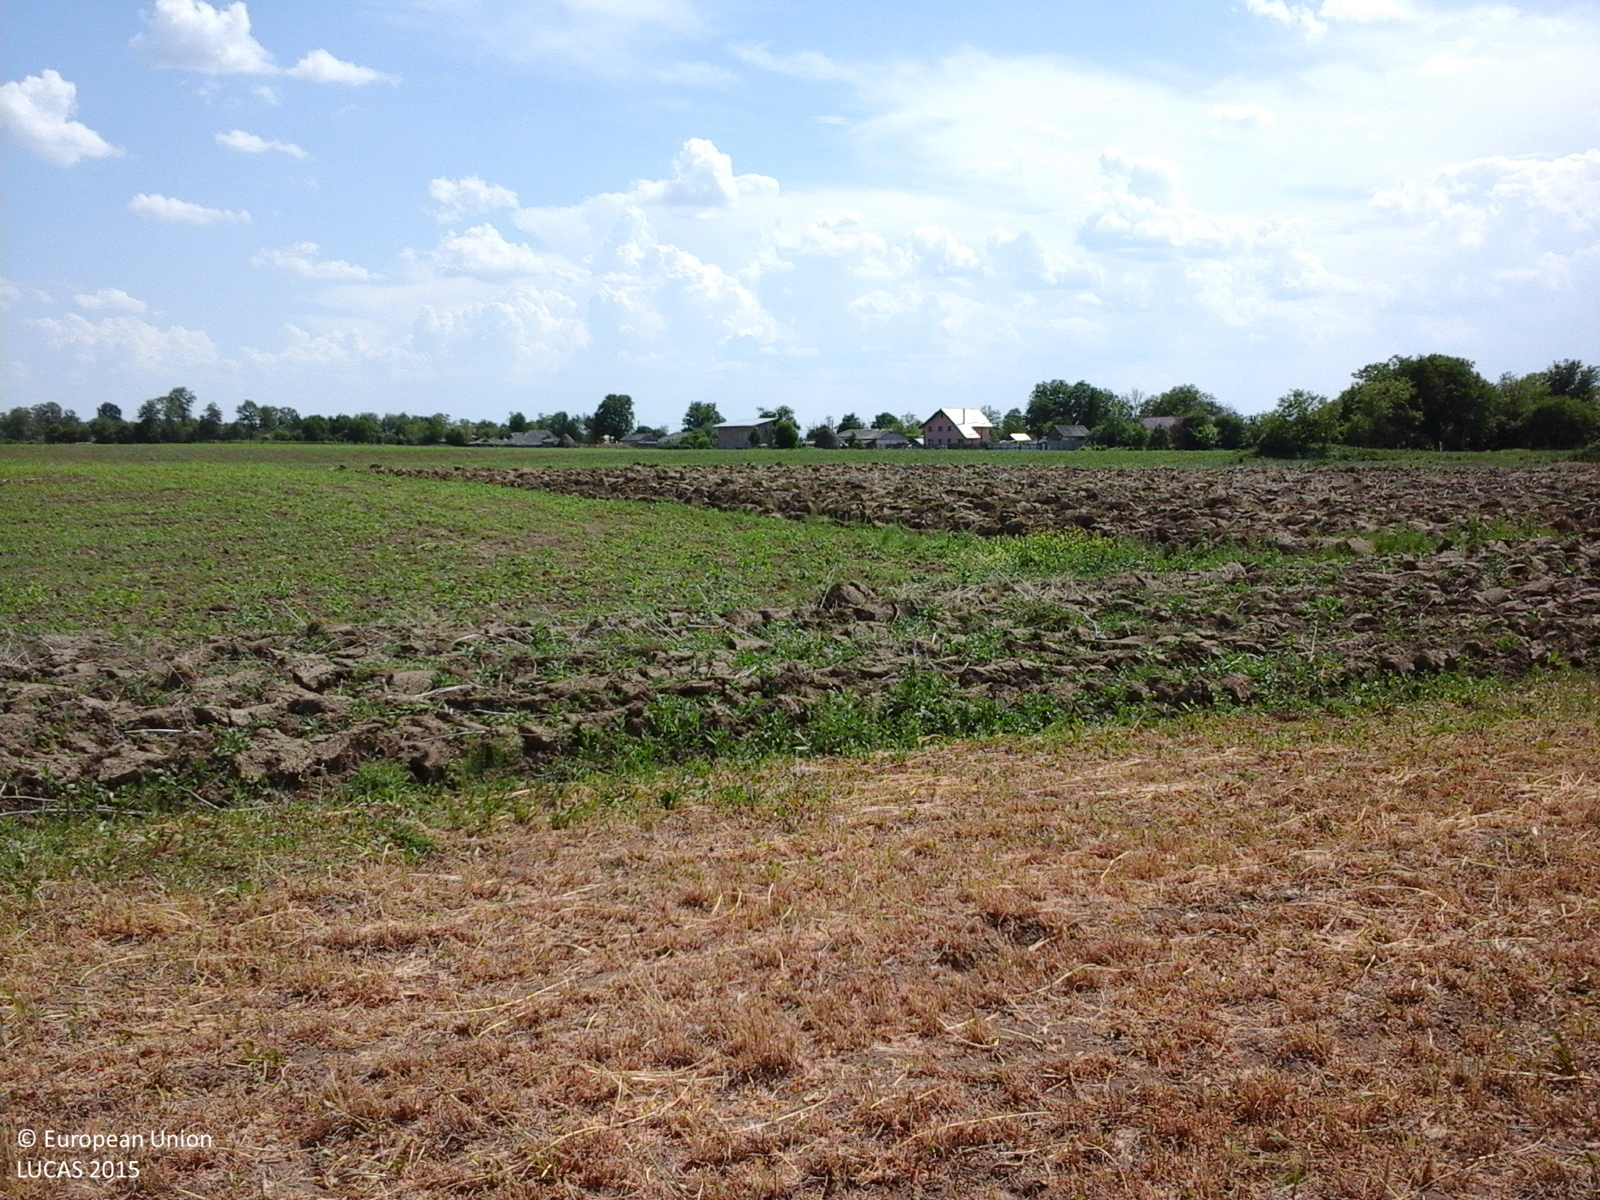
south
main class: Cropland
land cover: Lucerne
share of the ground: 10 - 25 %
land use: Agriculture (excluding fallow land and kitchen gardens)
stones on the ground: < 10 %
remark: Harvested field
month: June
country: RO
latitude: 46.7735
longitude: 26.9241
